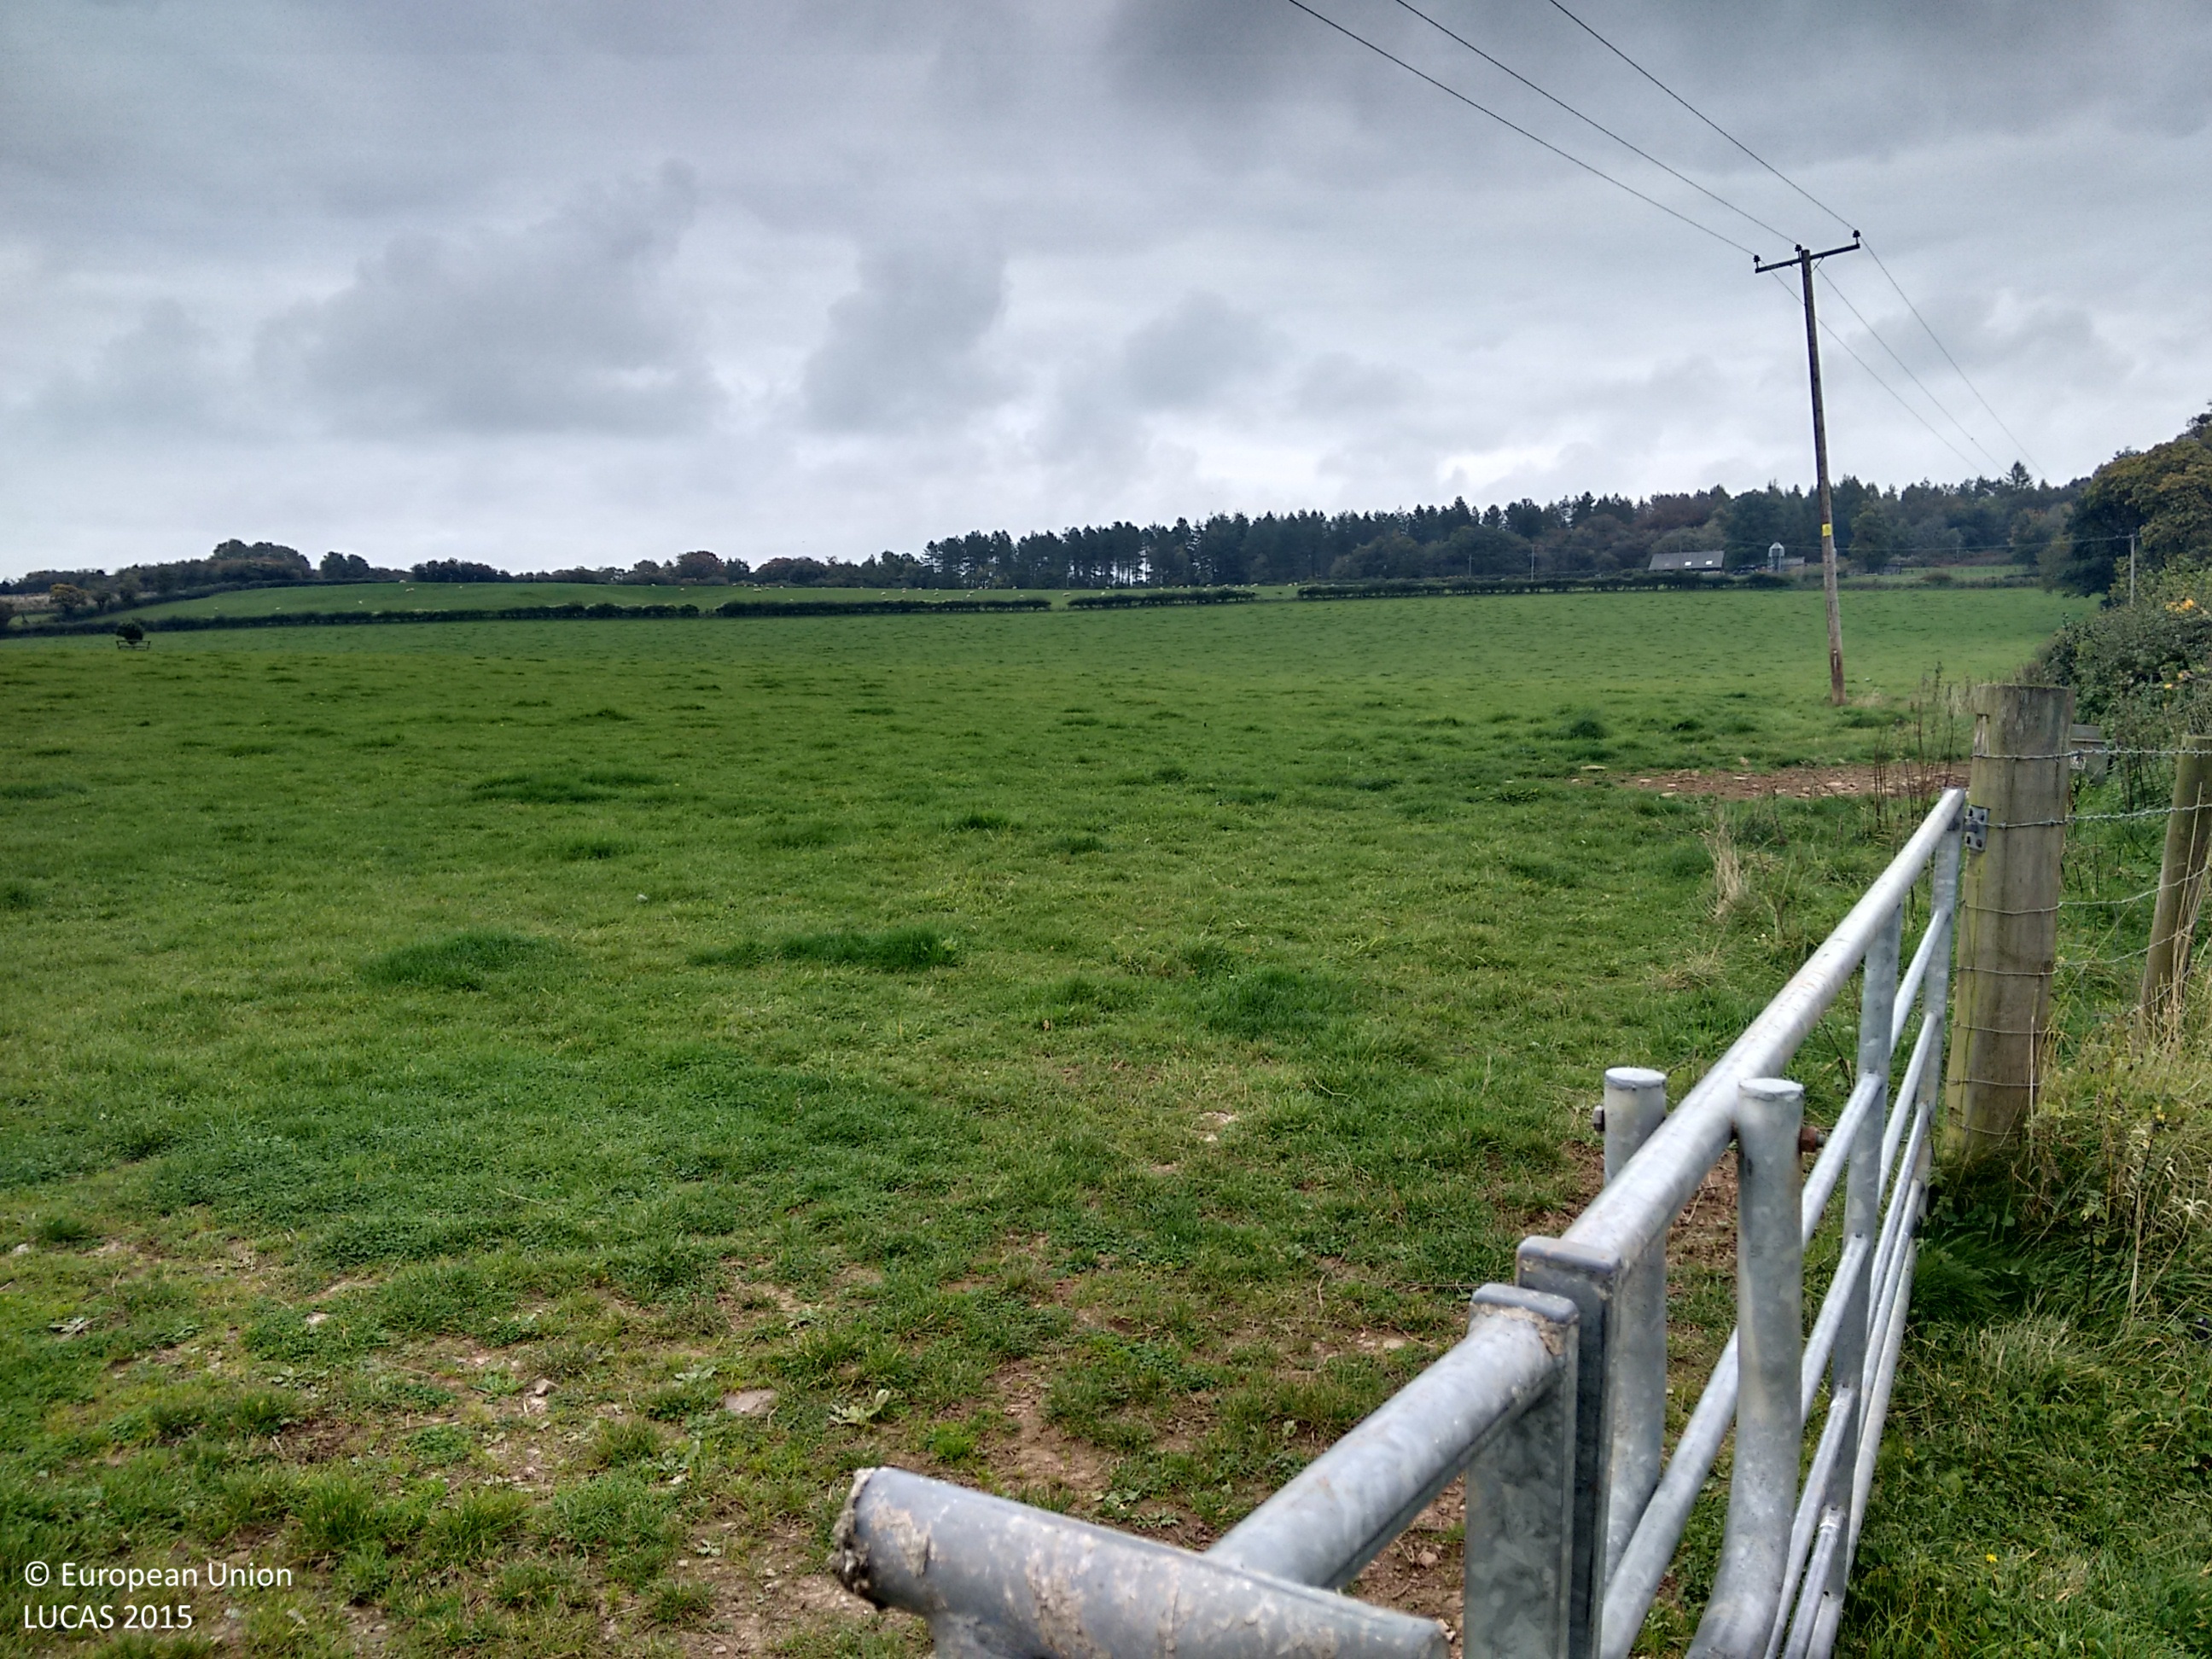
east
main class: Grassland
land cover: Grassland without tree/shrub cover
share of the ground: > 75 %
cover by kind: herbaceous plants 100 %
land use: Agriculture (excluding fallow land and kitchen gardens)
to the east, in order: Grassland without tree/shrub cover; Fences; Managed hedges; Fences; Grassland without tree/shrub cover
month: October
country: GB
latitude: 51.8311
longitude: -2.5911
